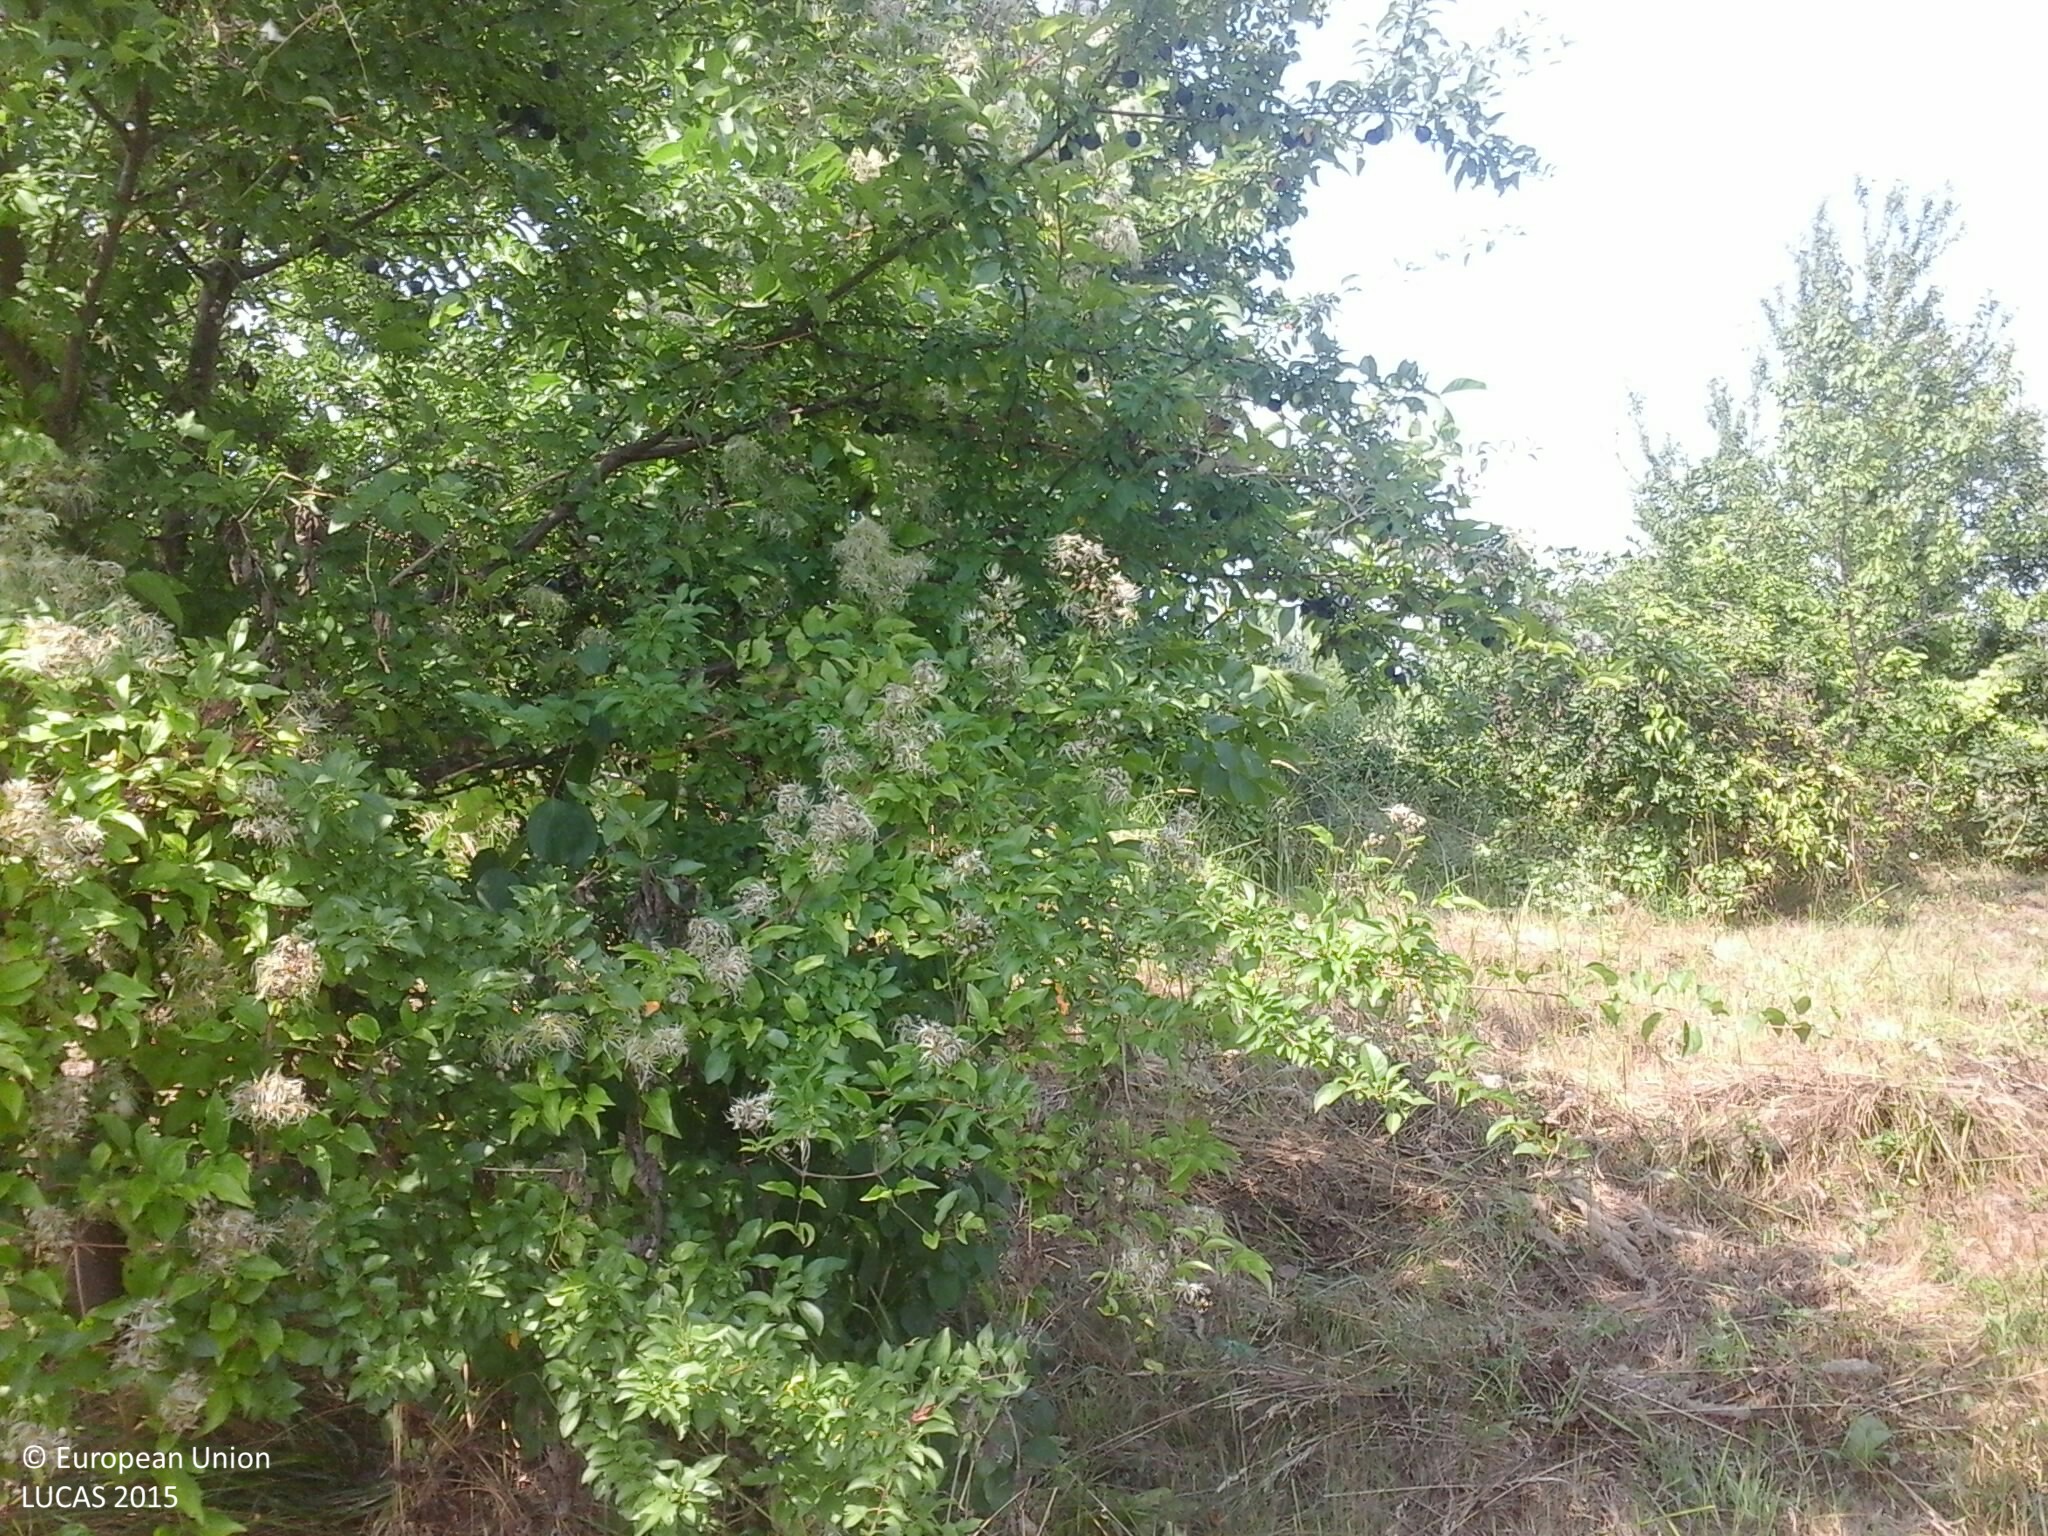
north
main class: Cropland
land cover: Permanent crops (only in case pi)
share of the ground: > 75 %
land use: Kitchen garden
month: July
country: HU
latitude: 46.7794
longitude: 17.1687
